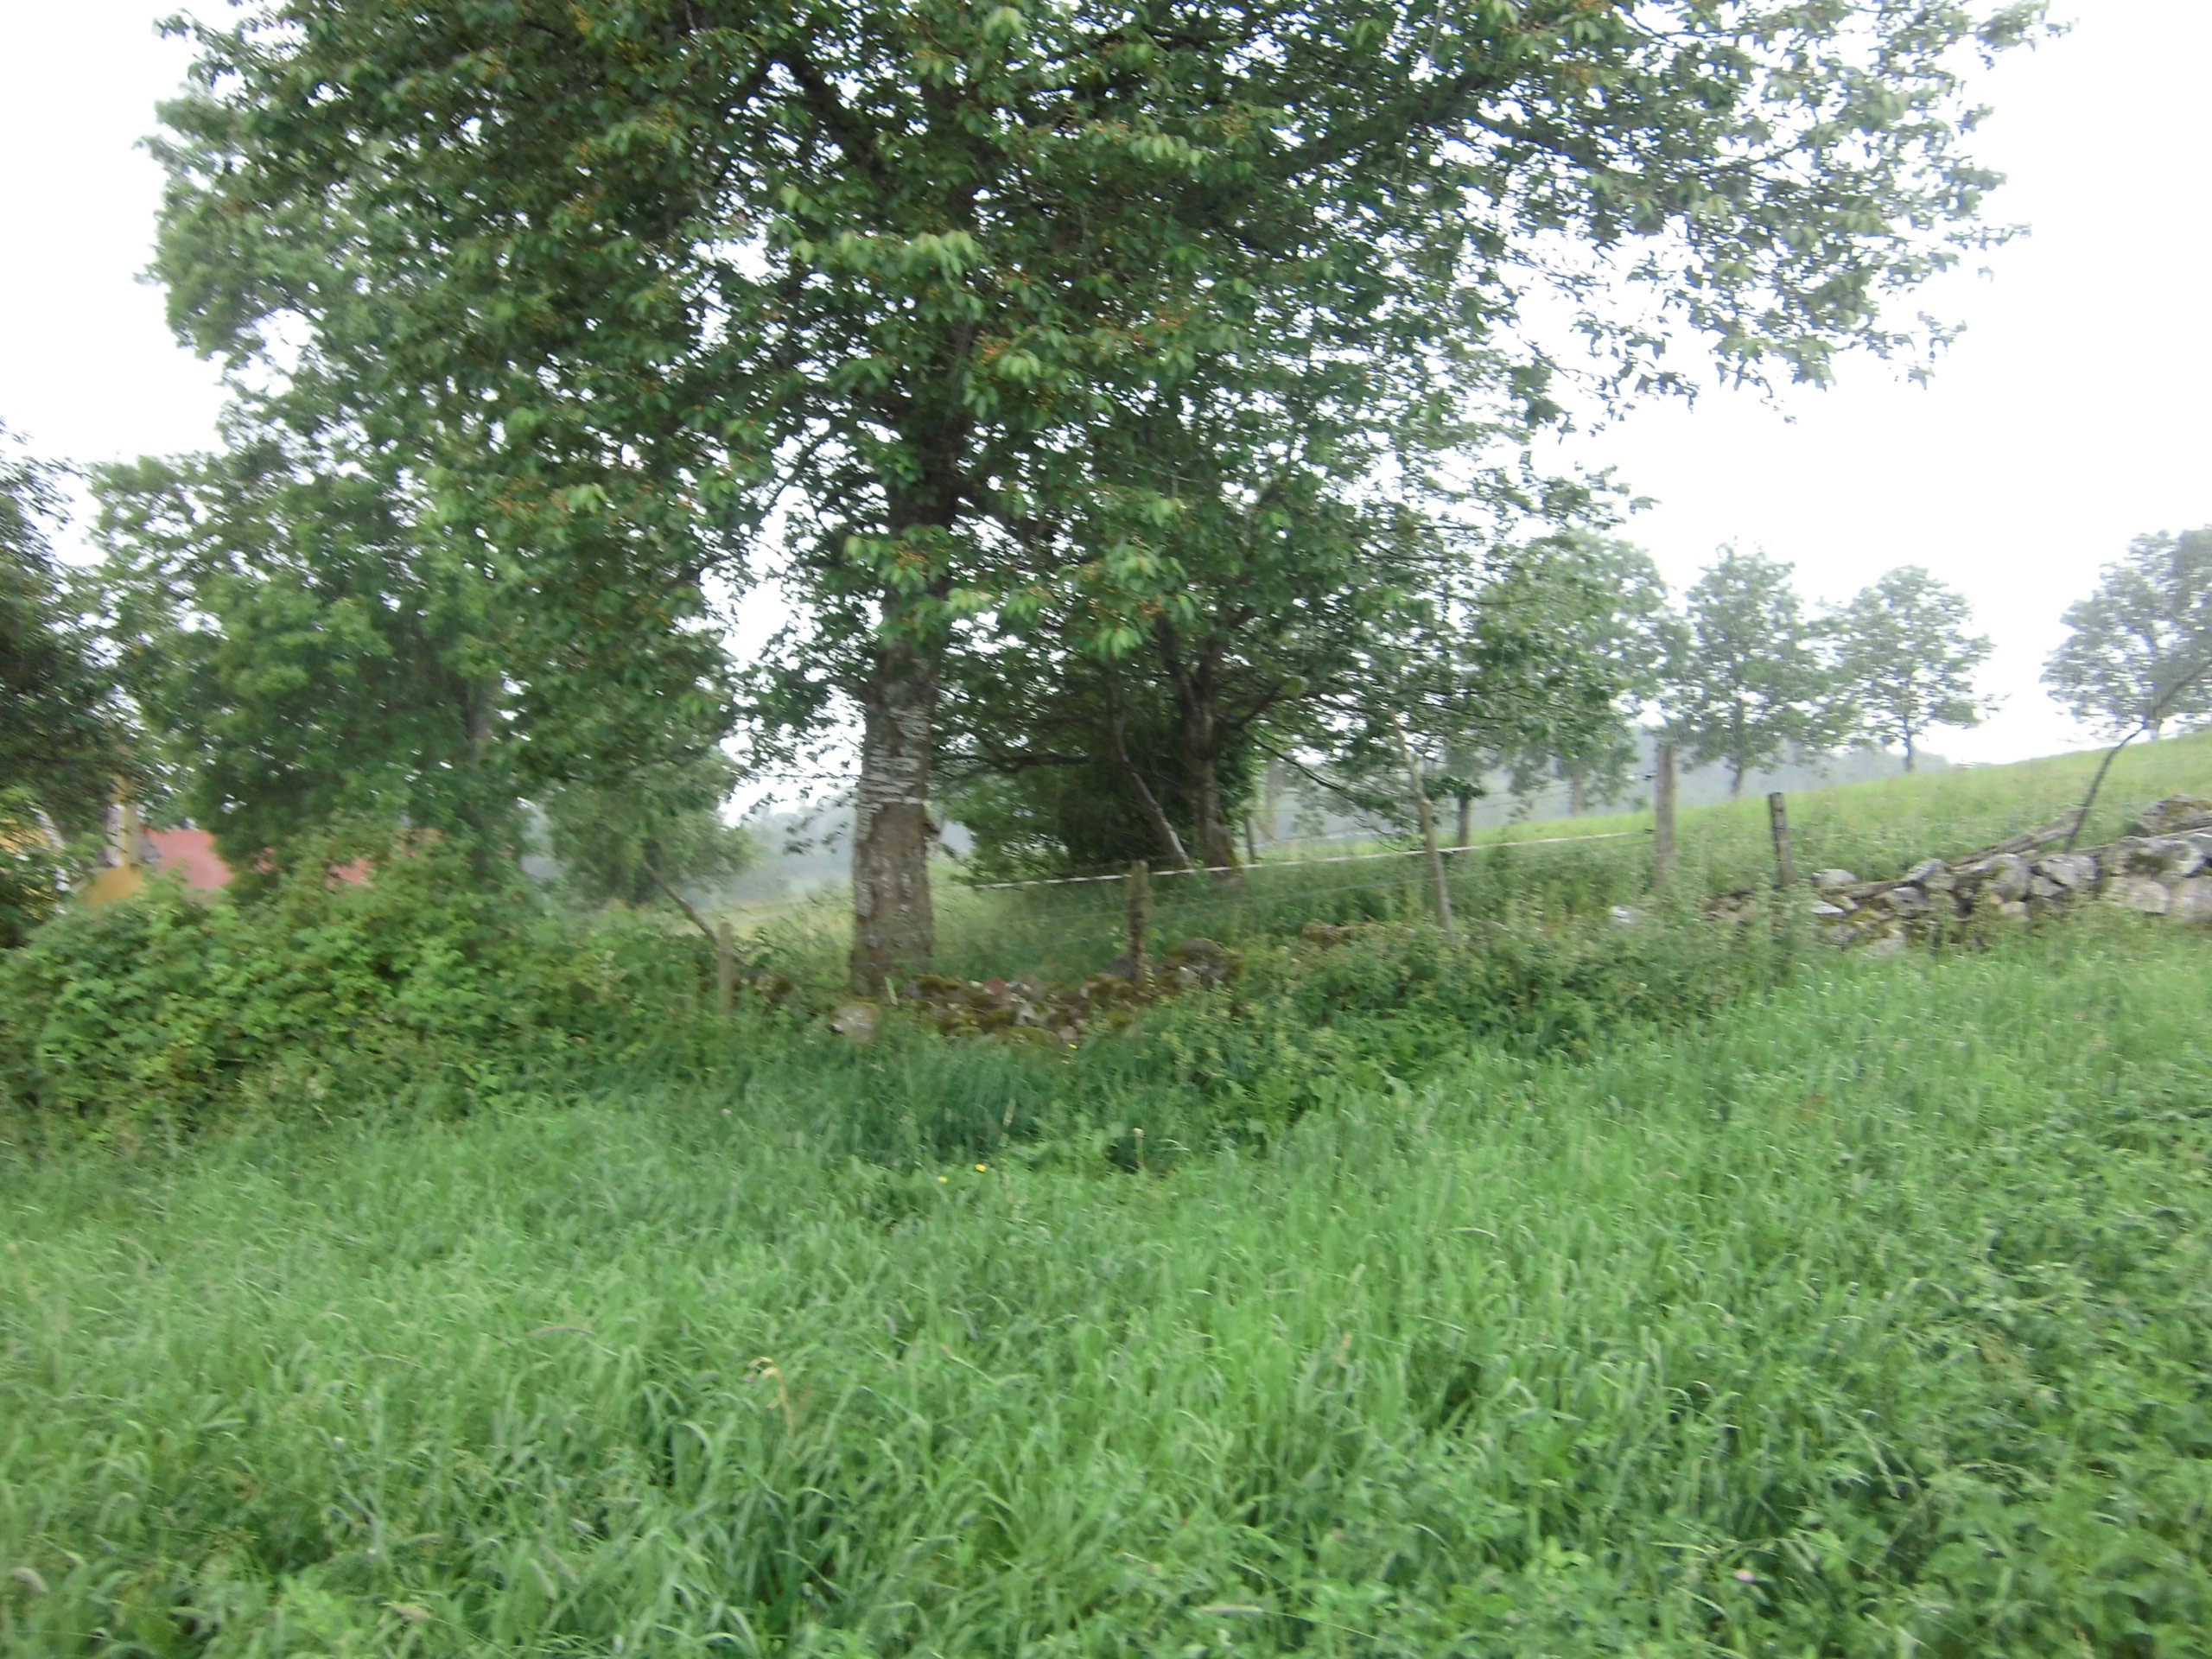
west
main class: Grassland
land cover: Grassland without tree/shrub cover
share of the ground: > 75 %
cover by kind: herbaceous plants 100 %
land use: Agriculture (excluding fallow land and kitchen gardens)
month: July
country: SE
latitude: 57.4079
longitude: 14.9399
